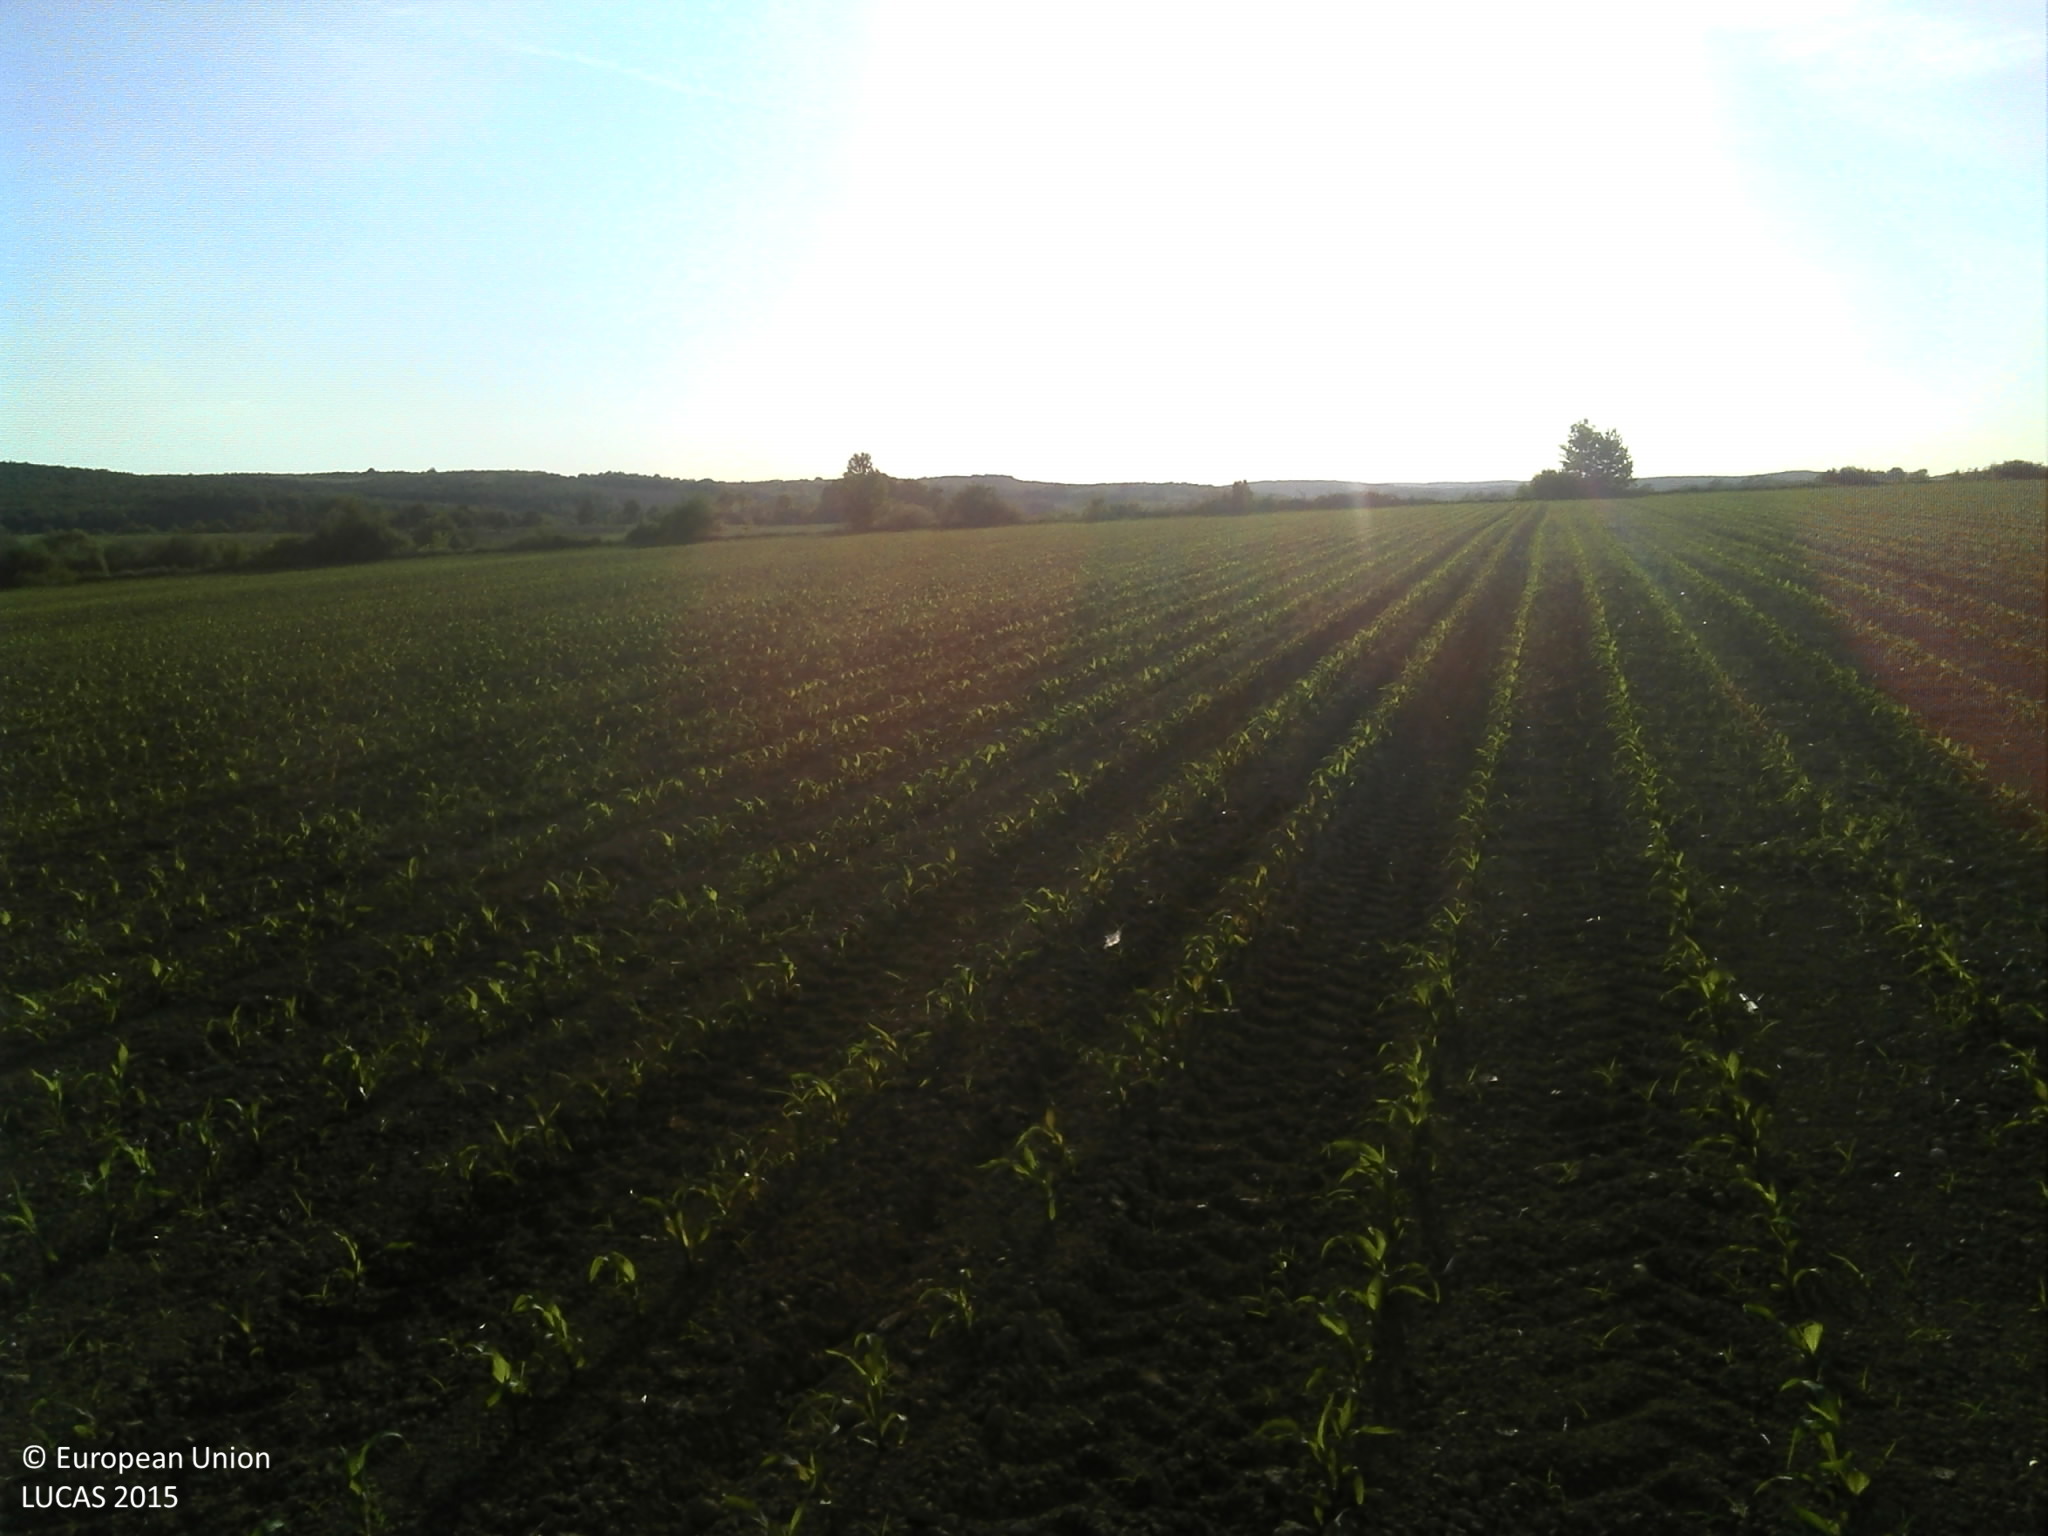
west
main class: Cropland
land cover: Maize
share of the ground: < 10 %
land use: Agriculture (excluding fallow land and kitchen gardens)
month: May
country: HR
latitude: 45.2358
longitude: 18.2455
